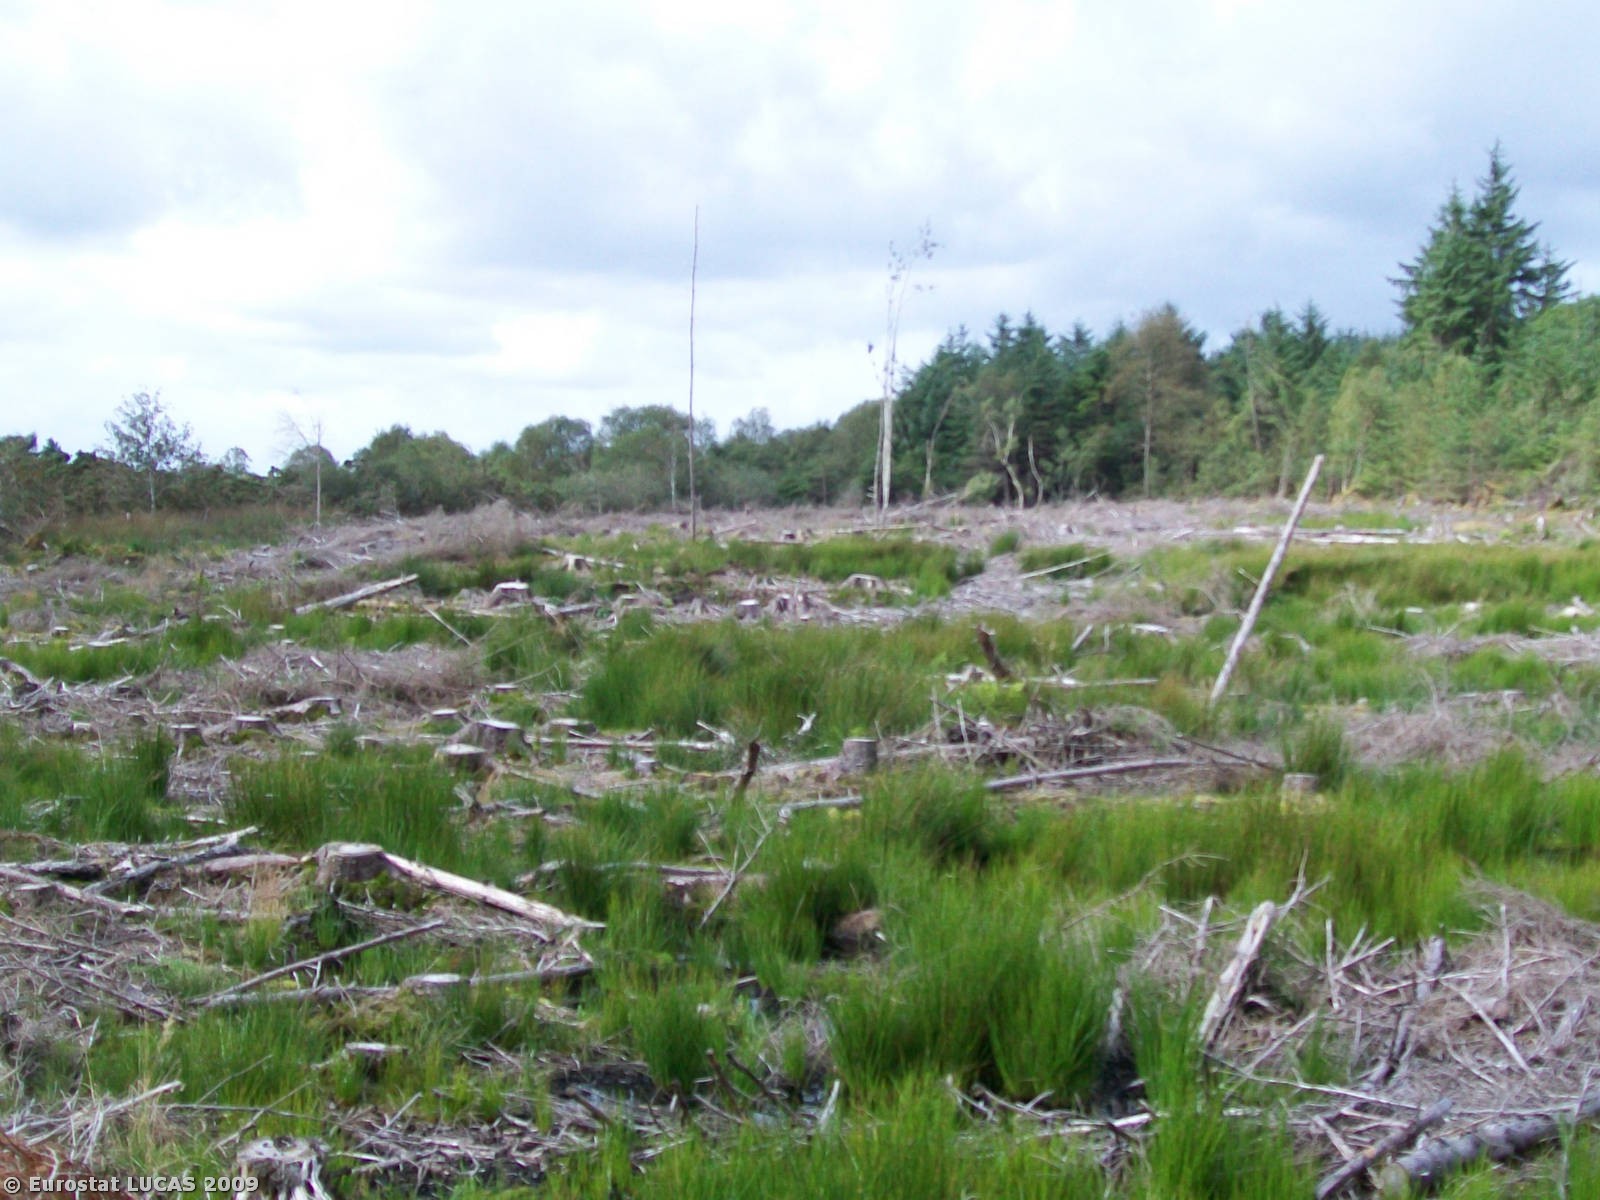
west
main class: Woodland
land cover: Coniferous woodland
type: plantations and self-sown exotic forest
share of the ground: > 75 %
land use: Forestry
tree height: > 5 m
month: August
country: IE
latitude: 53.0255
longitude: -8.6420
